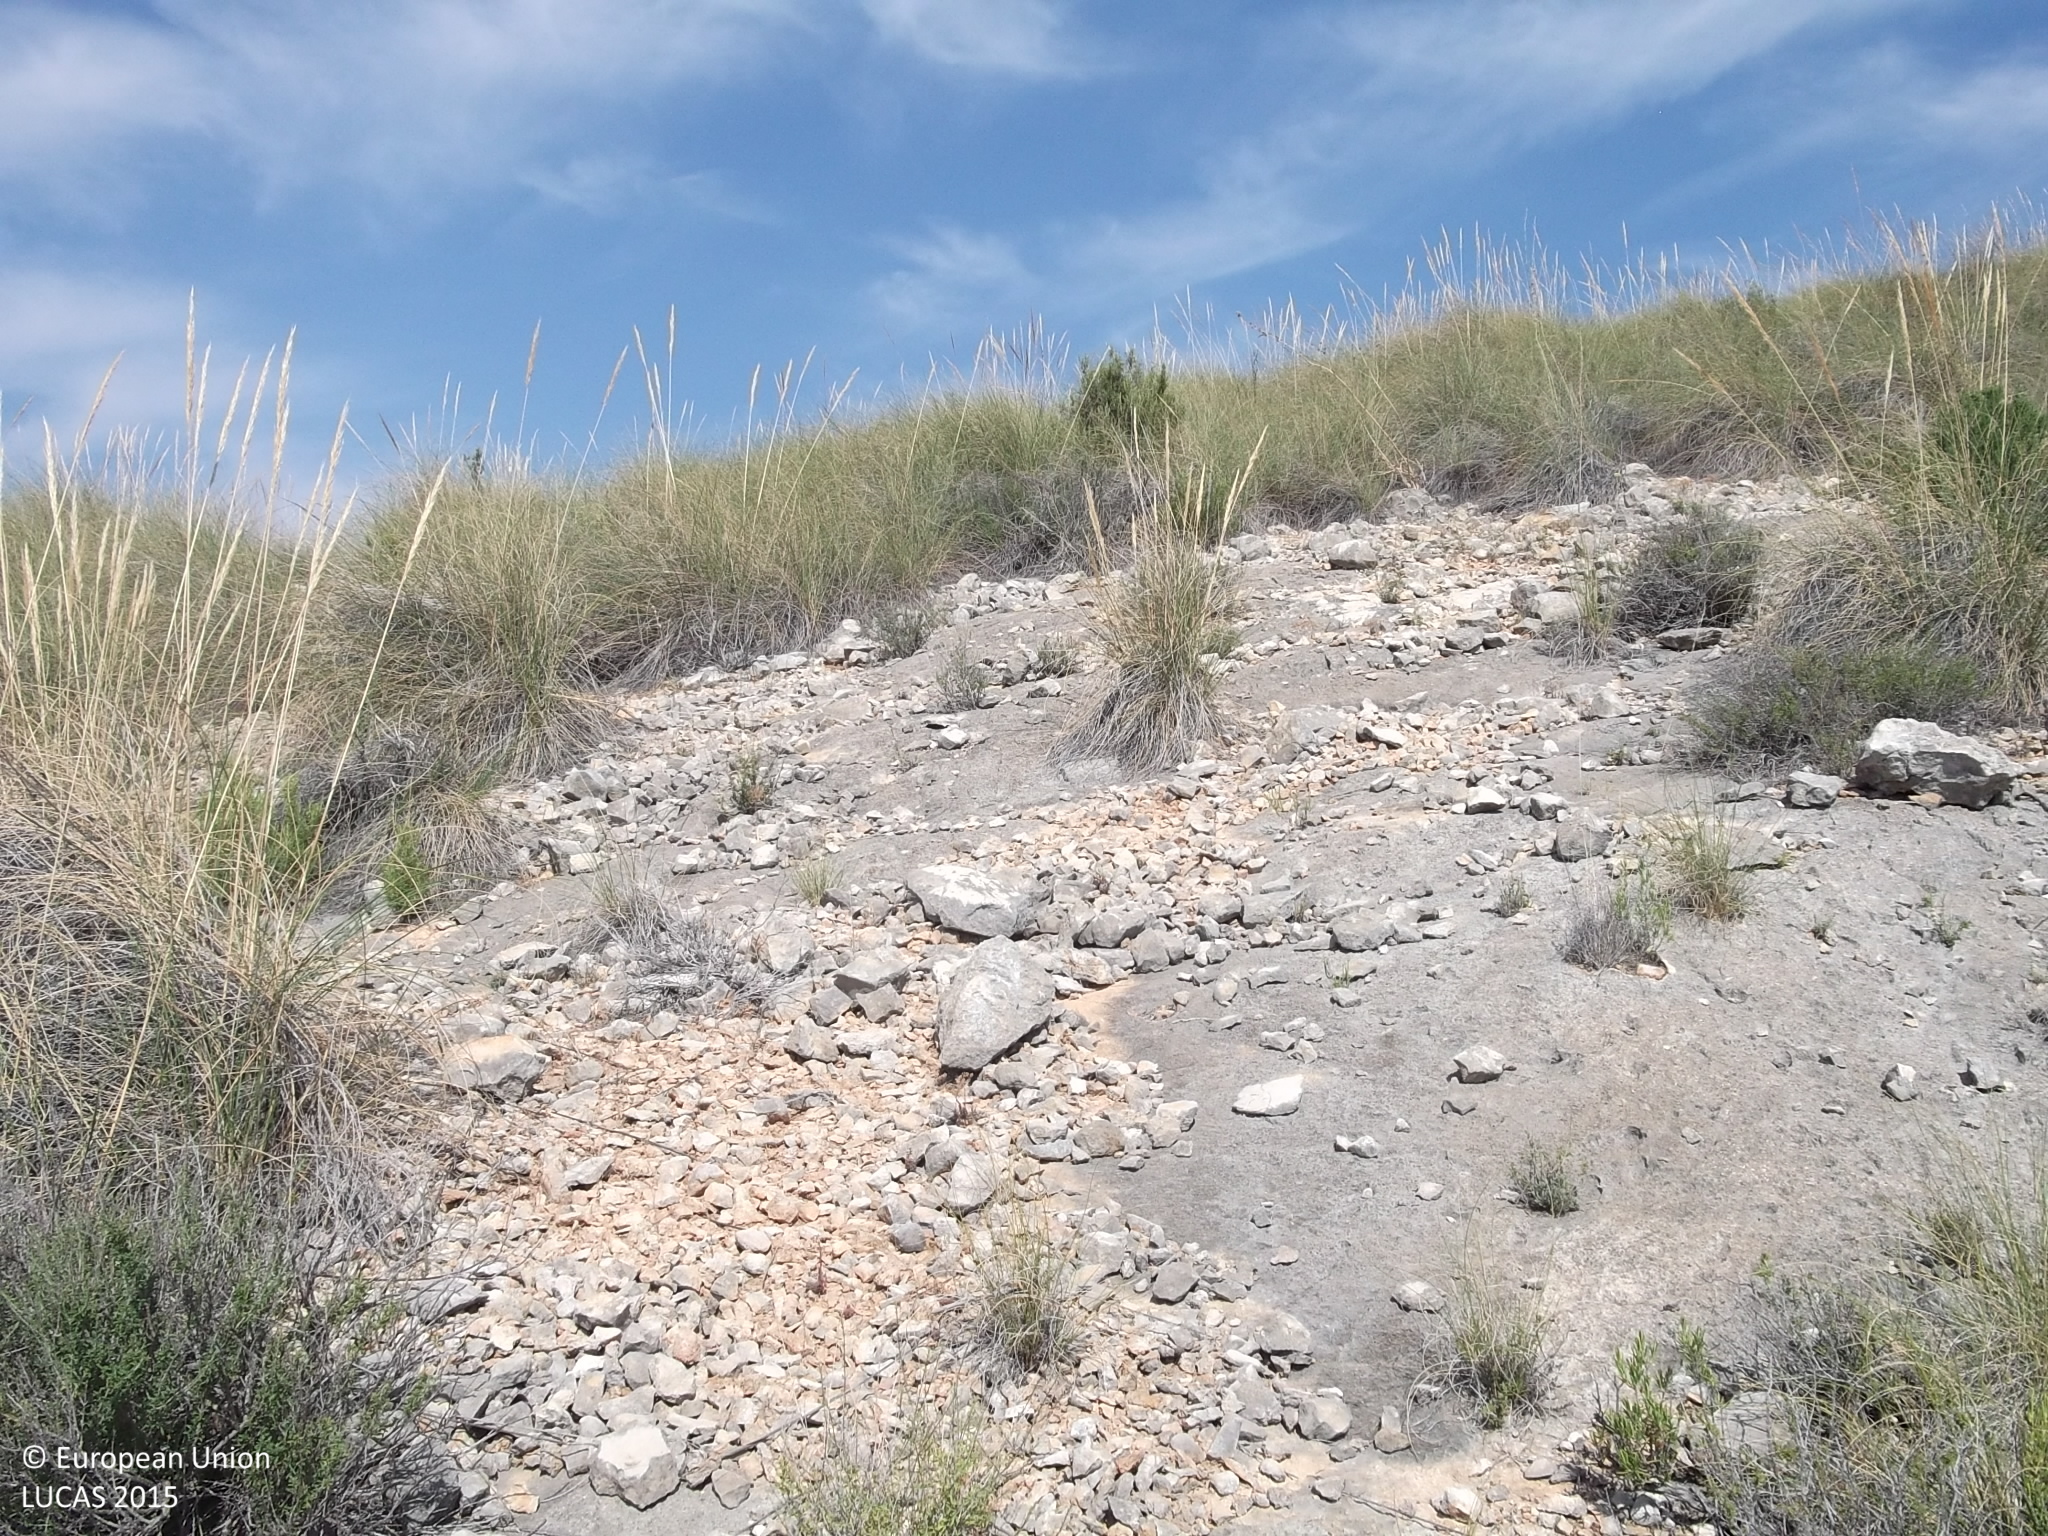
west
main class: Shrubland
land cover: Shrubland without tree cover
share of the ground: 25 - 50 %
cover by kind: shrubs 40 %, herbaceous plants 30 %, consolidated bare surface 30 %
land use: Semi-natural and natural areas not in use
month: June
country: ES
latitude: 38.4354
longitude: -1.3664
